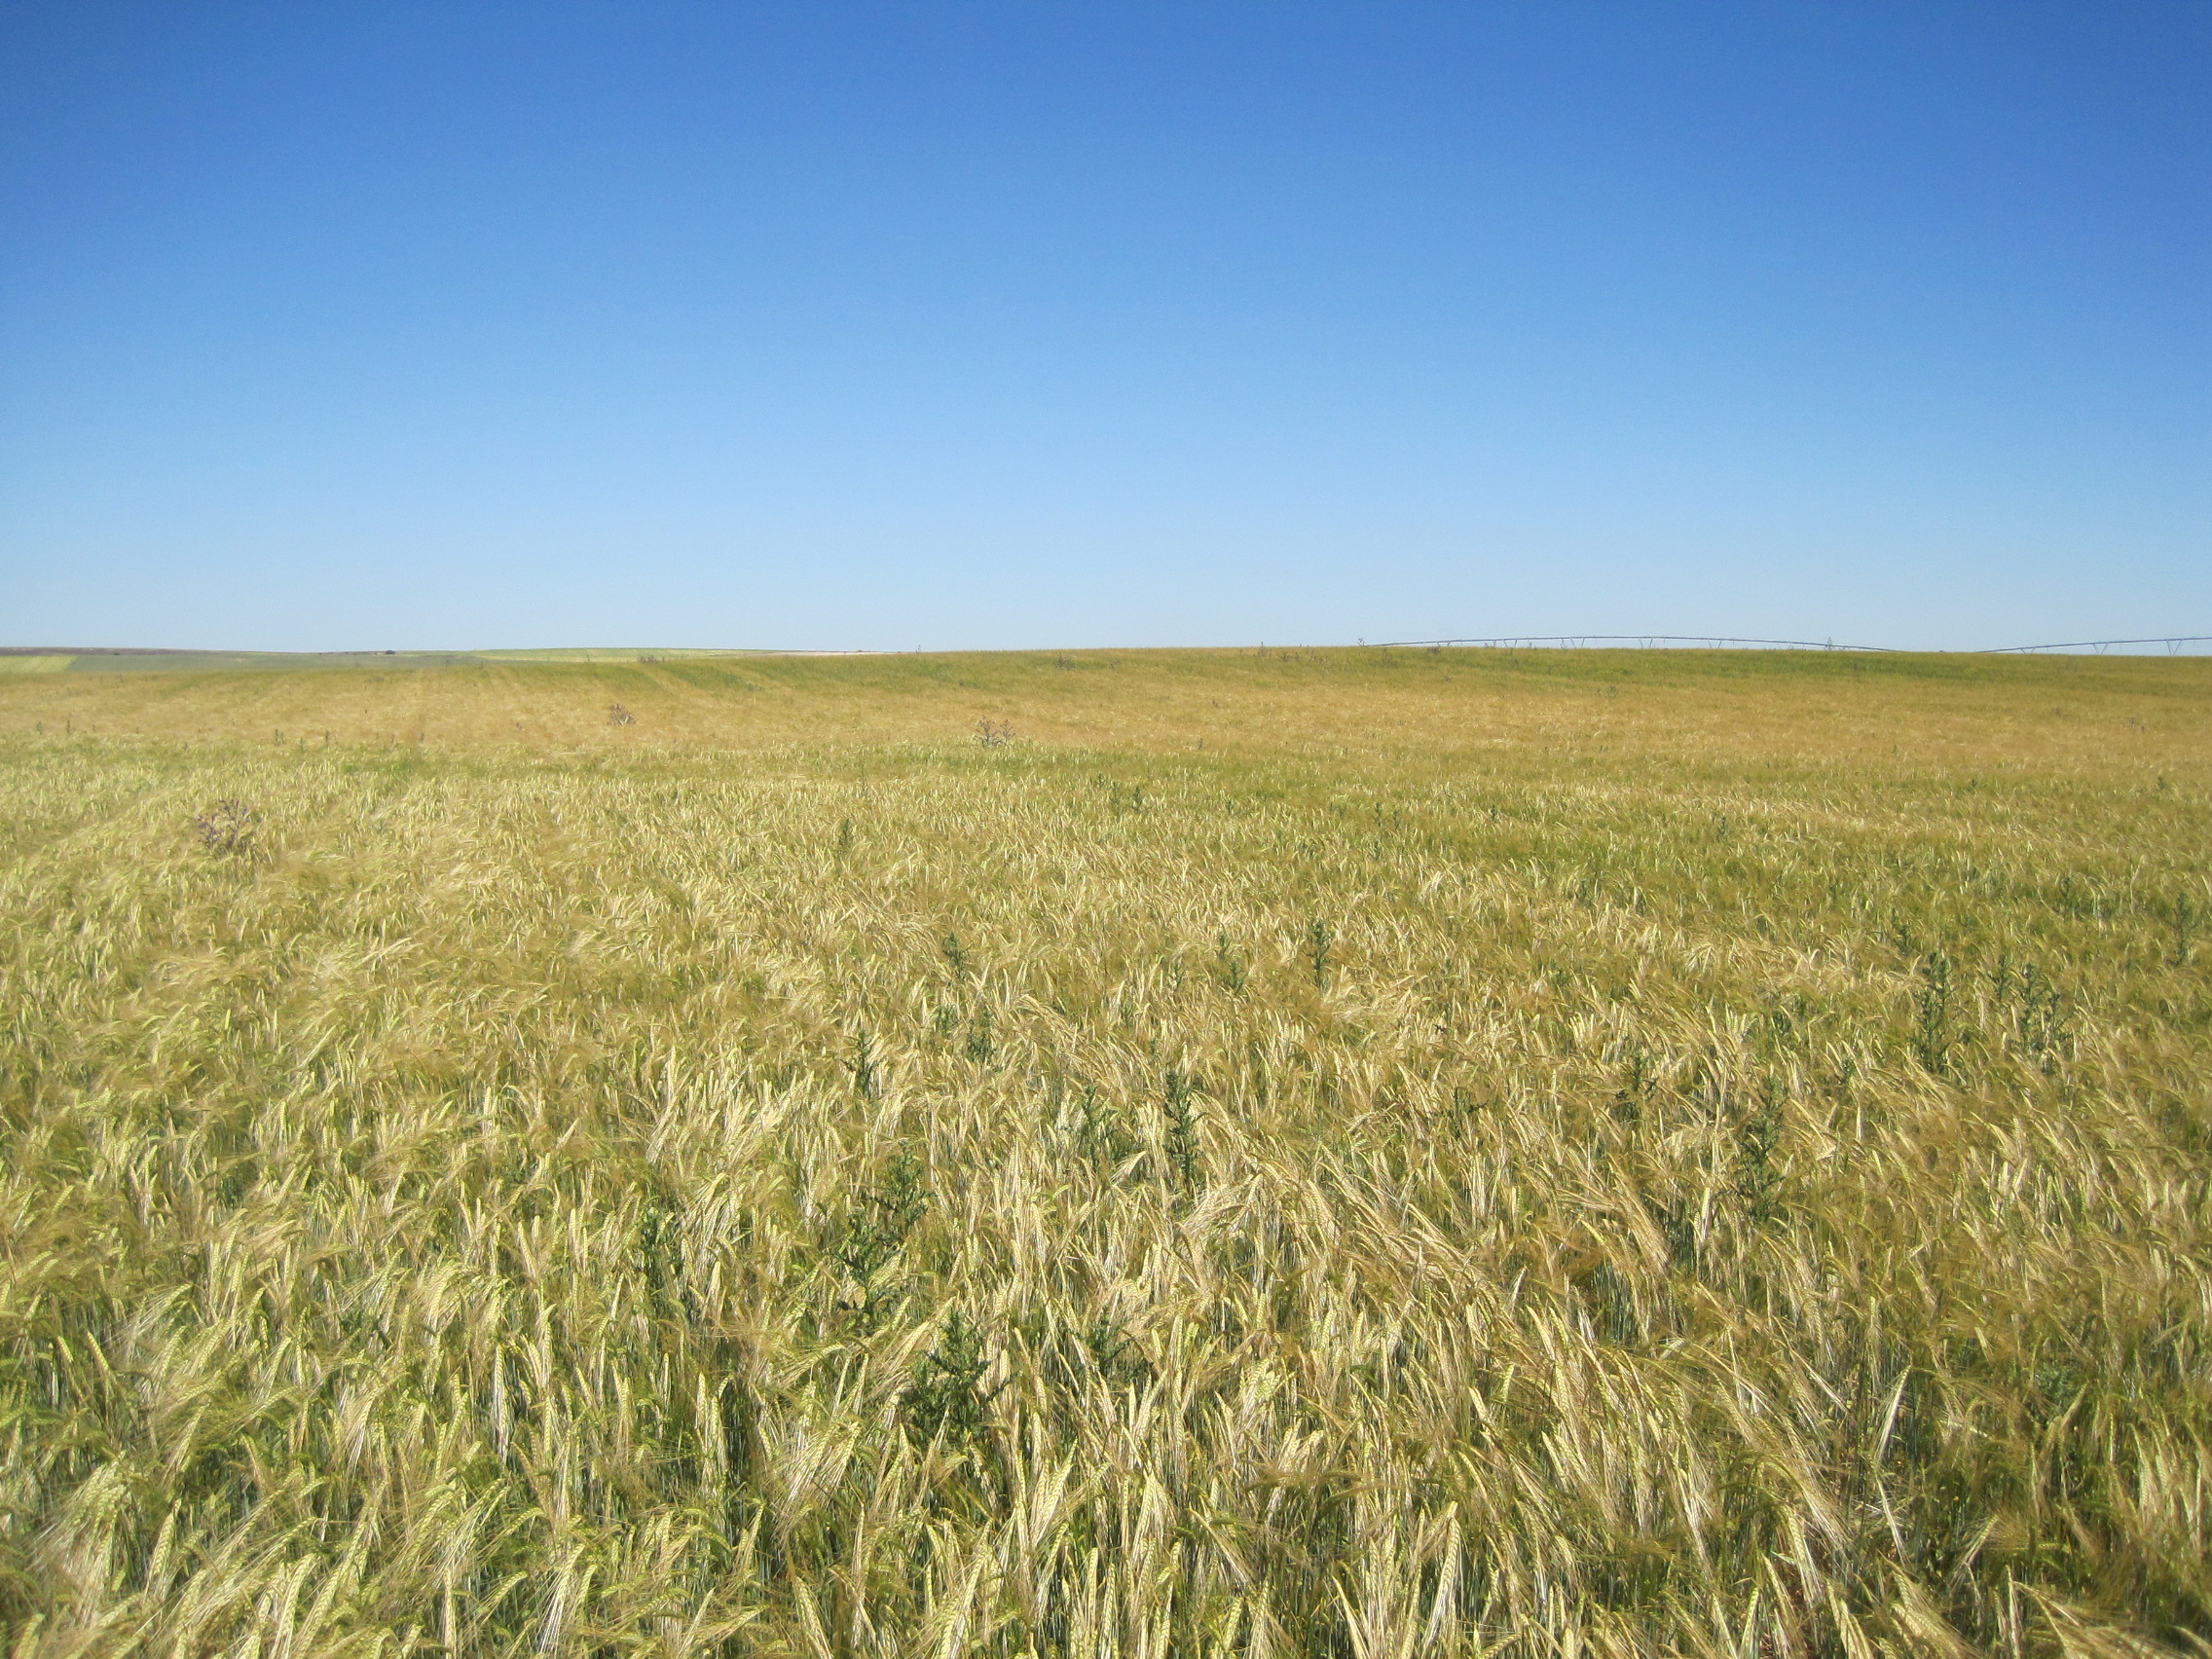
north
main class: Cropland
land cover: Barley
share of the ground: > 75 %
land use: Agriculture (excluding fallow land and kitchen gardens)
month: May
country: ES
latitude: 41.2822
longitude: -5.2976
